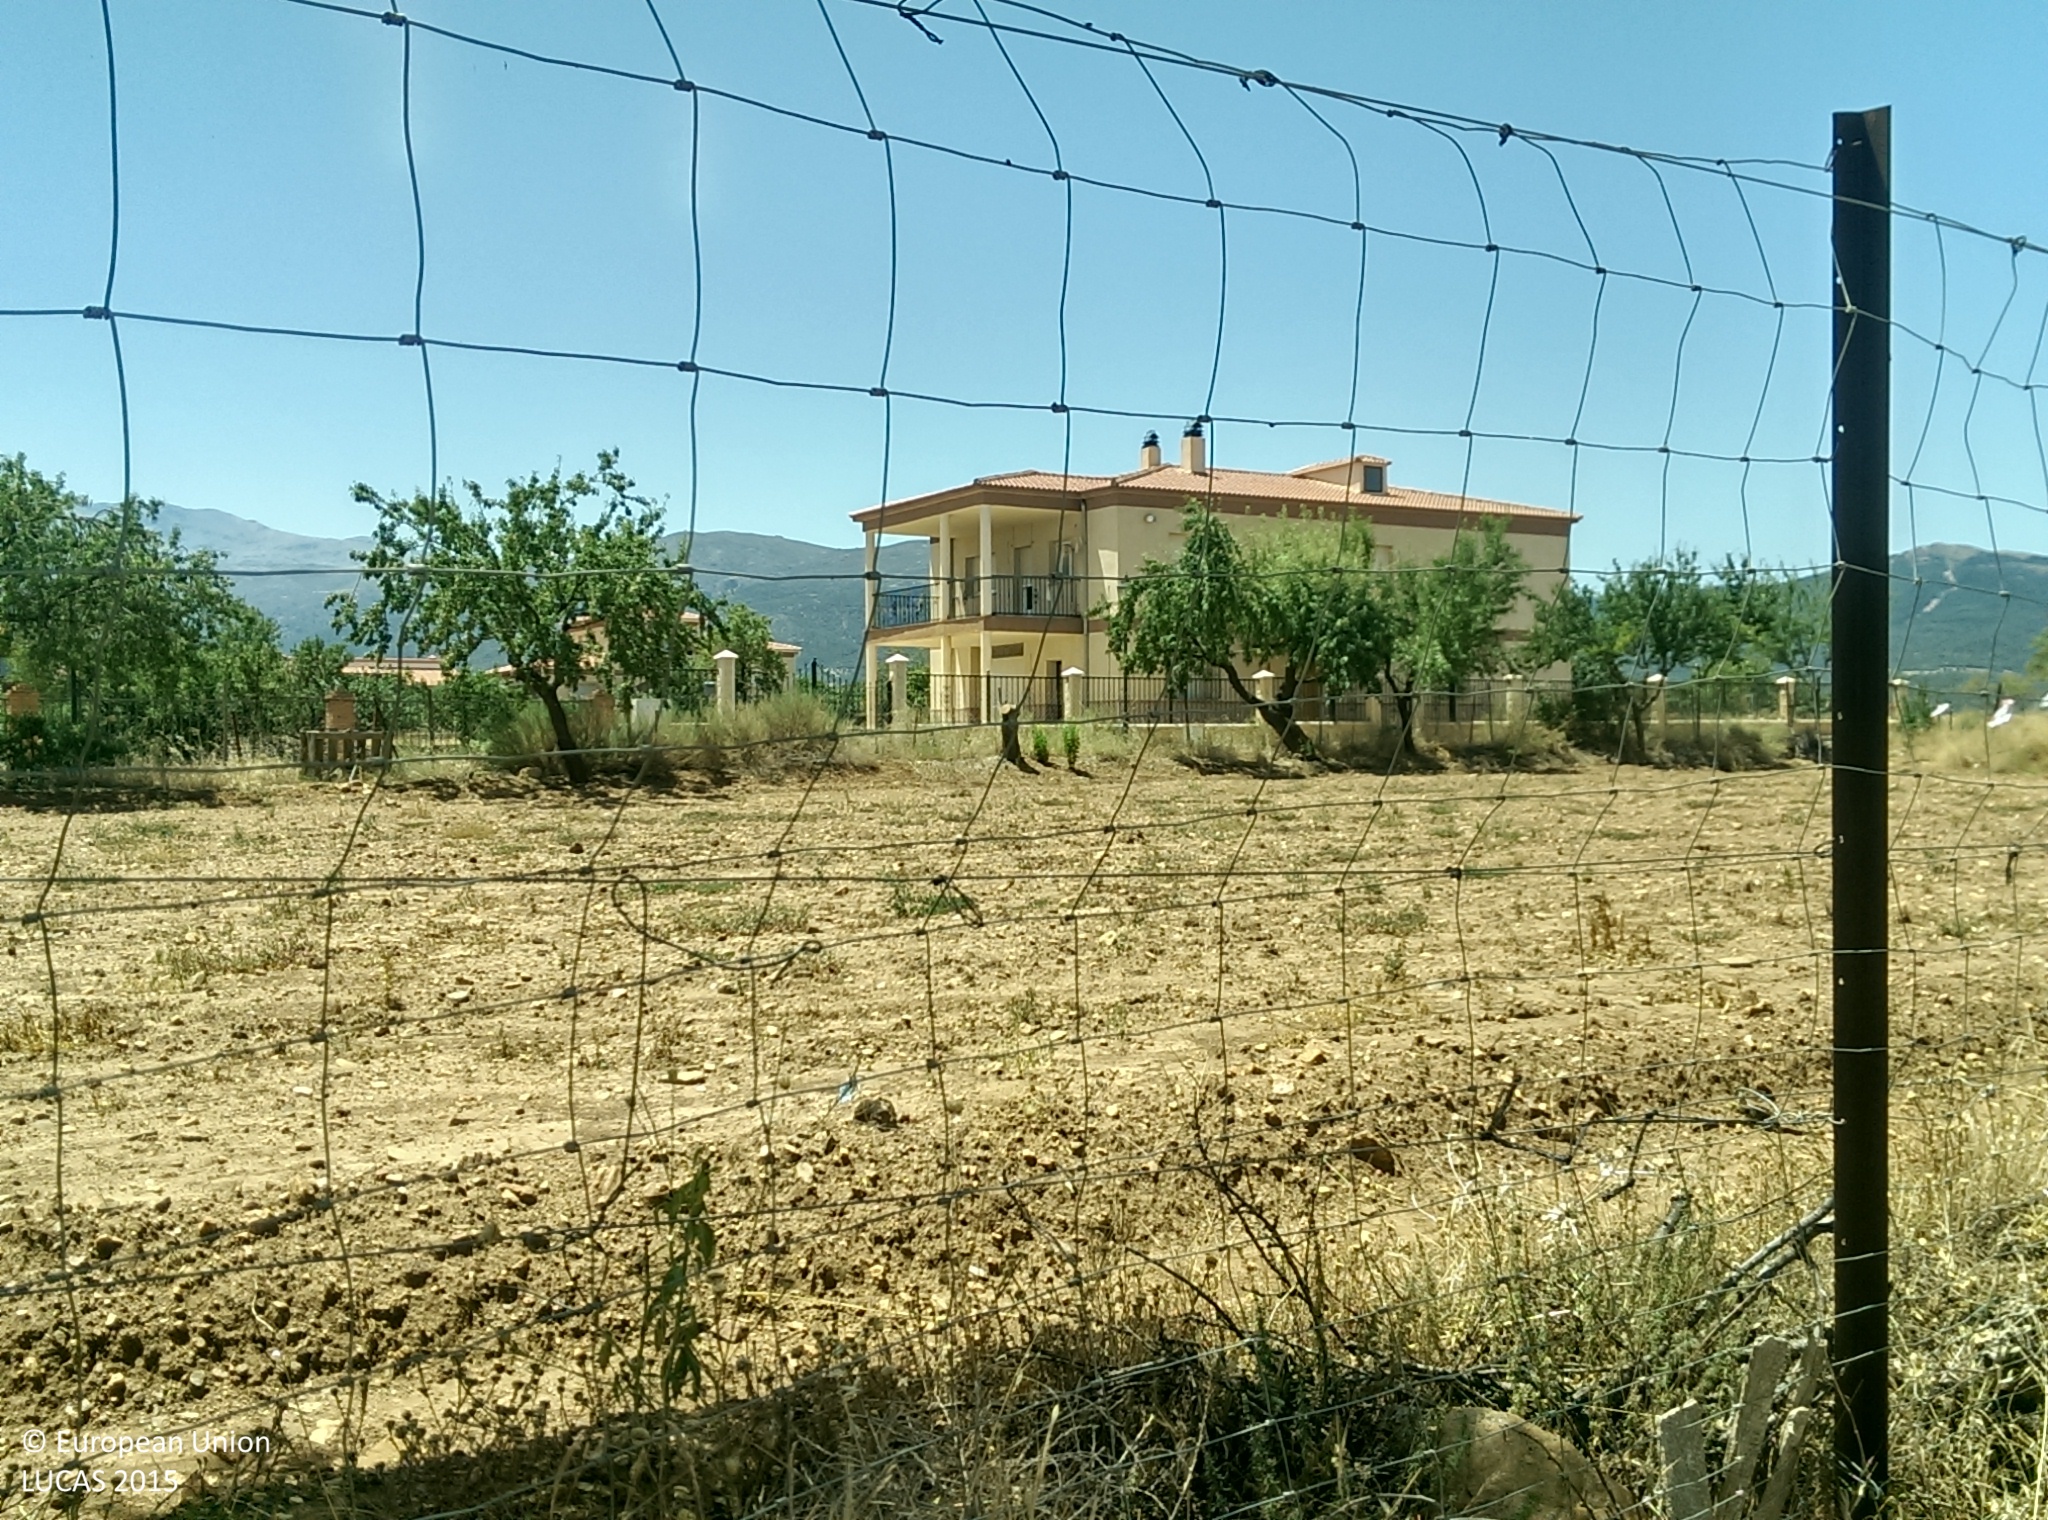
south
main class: Cropland
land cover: Barley
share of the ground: < 10 %
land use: Agriculture (excluding fallow land and kitchen gardens)
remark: Harvested field
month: July
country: ES
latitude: 37.2584
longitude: -3.2357
